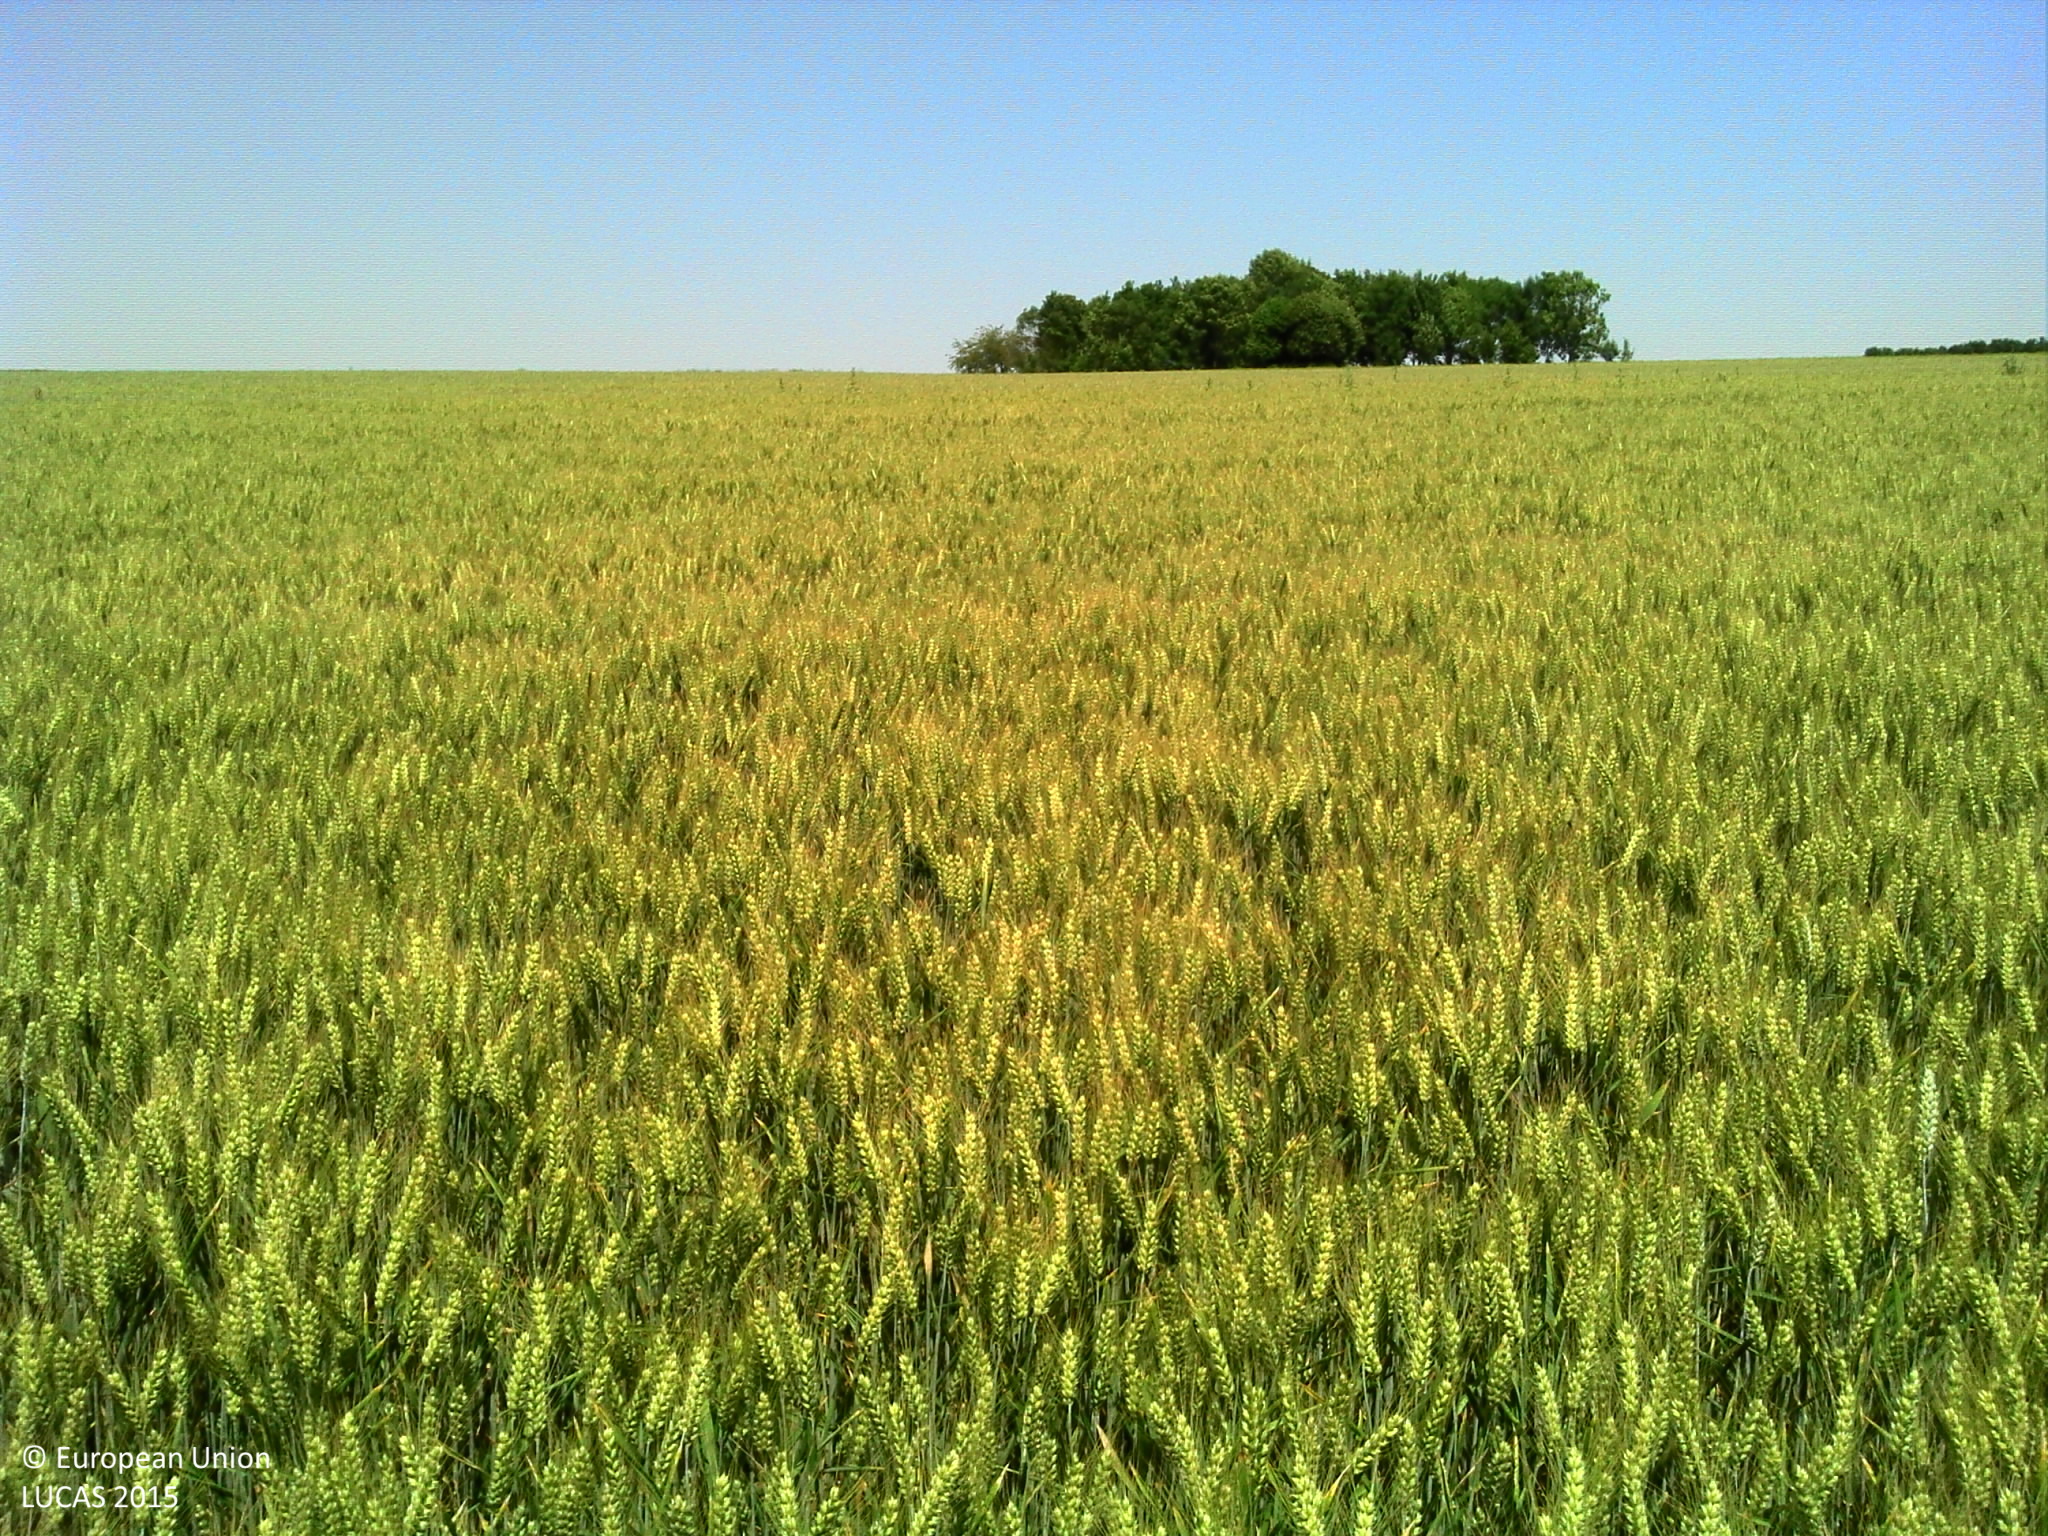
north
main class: Cropland
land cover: Common wheat
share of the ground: > 75 %
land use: Agriculture (excluding fallow land and kitchen gardens)
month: July
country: FR
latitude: 50.2807
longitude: 2.5078
